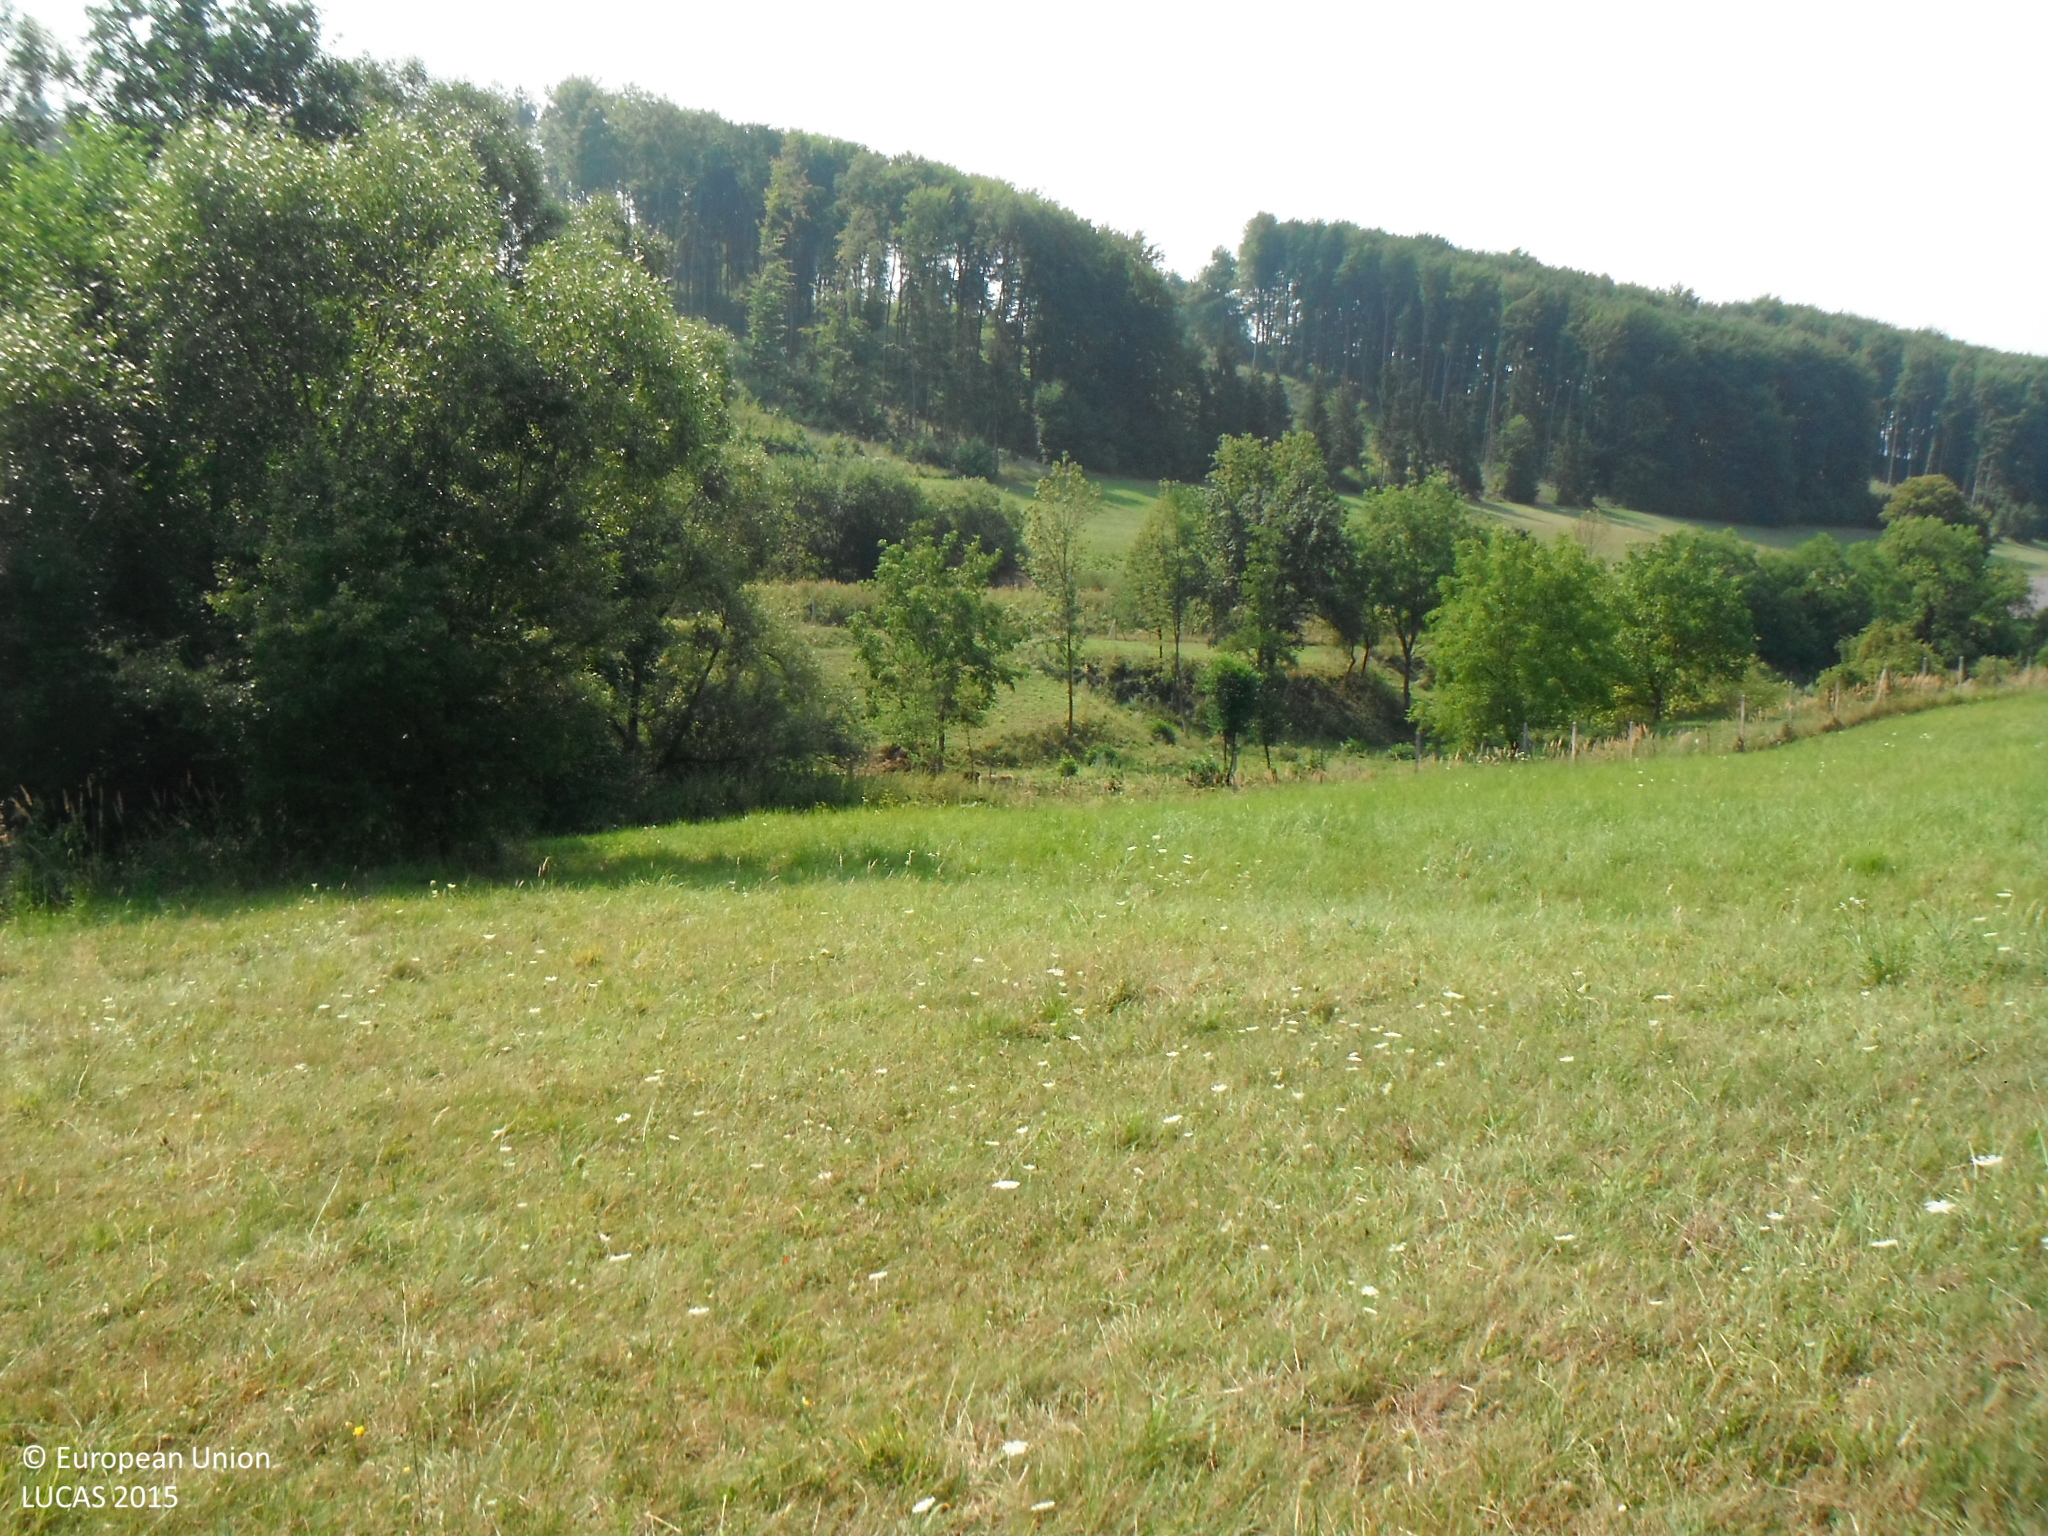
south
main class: Grassland
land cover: Grassland without tree/shrub cover
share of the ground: > 75 %
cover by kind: herbaceous plants 100 %
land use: Agriculture (excluding fallow land and kitchen gardens)
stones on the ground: < 10 %
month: August
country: SK
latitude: 49.0796
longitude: 18.3821
